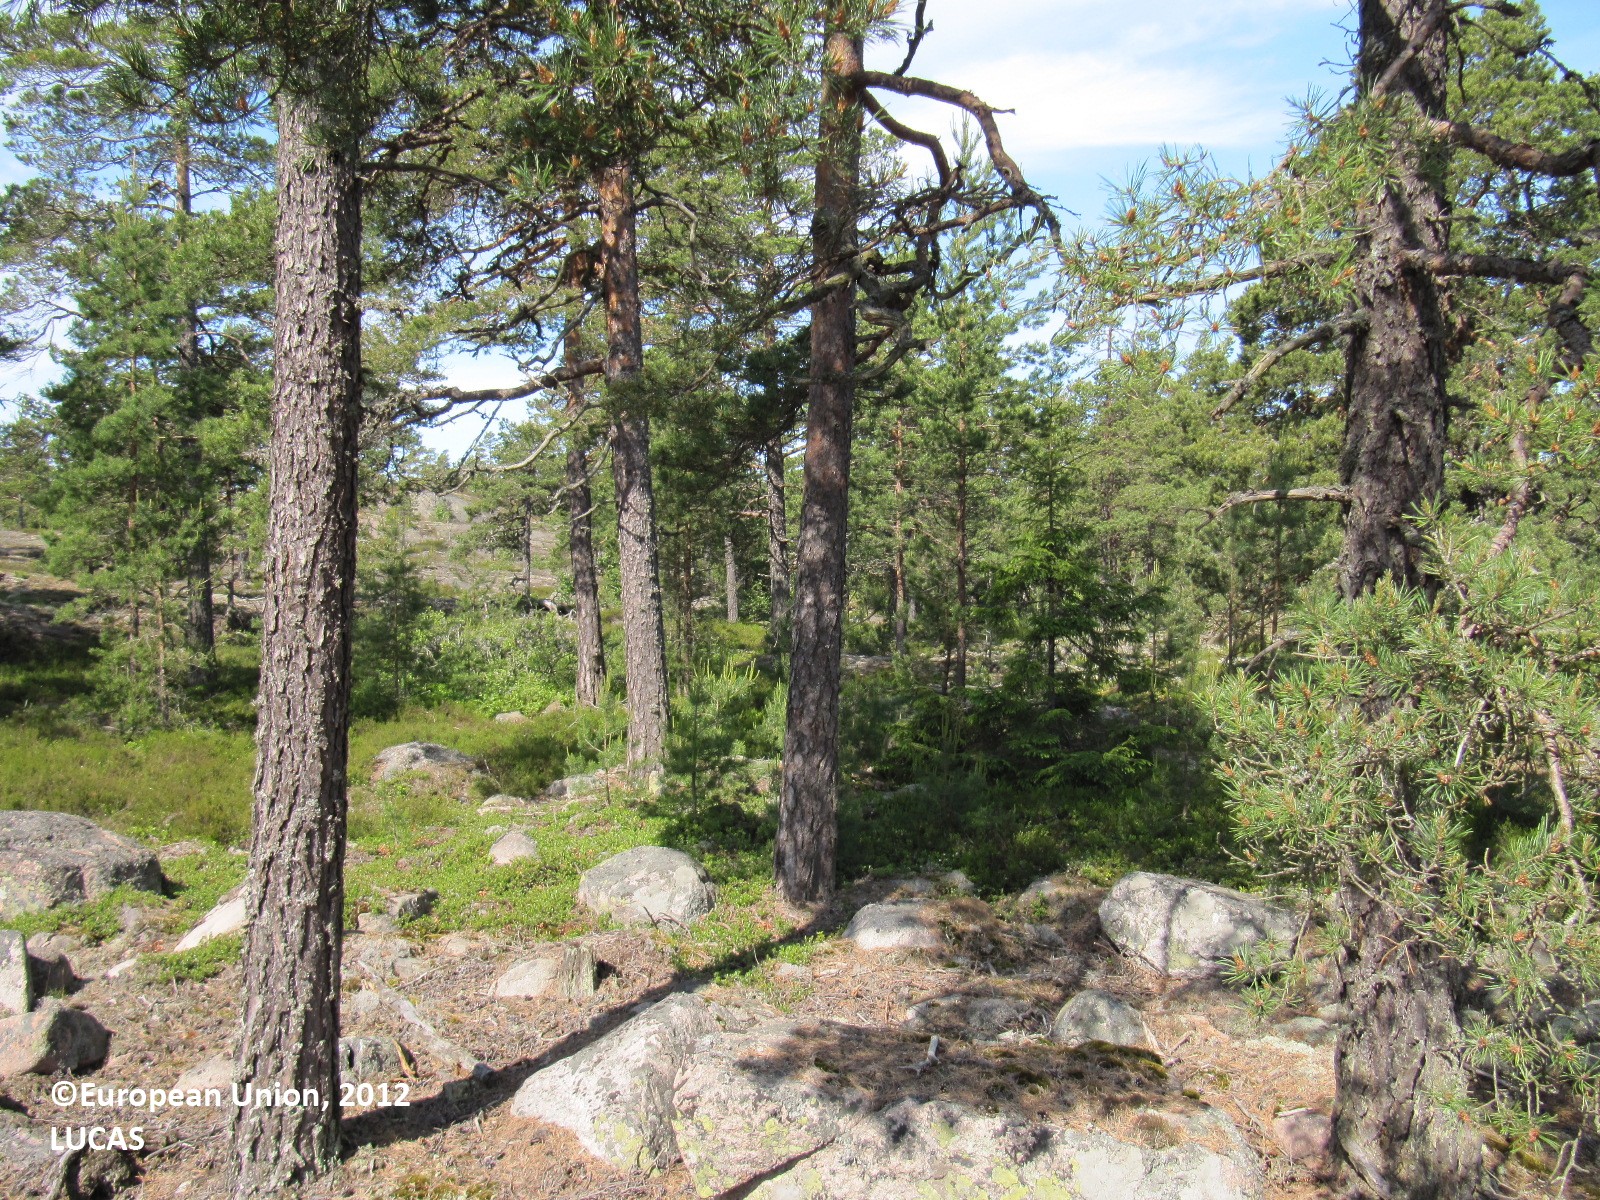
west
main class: Woodland
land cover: Pine dominated coniferous woodland
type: boreal forest
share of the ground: 25 - 50 %
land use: Forestry
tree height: > 5 m
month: June
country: FI
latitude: 59.9282
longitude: 22.9447
